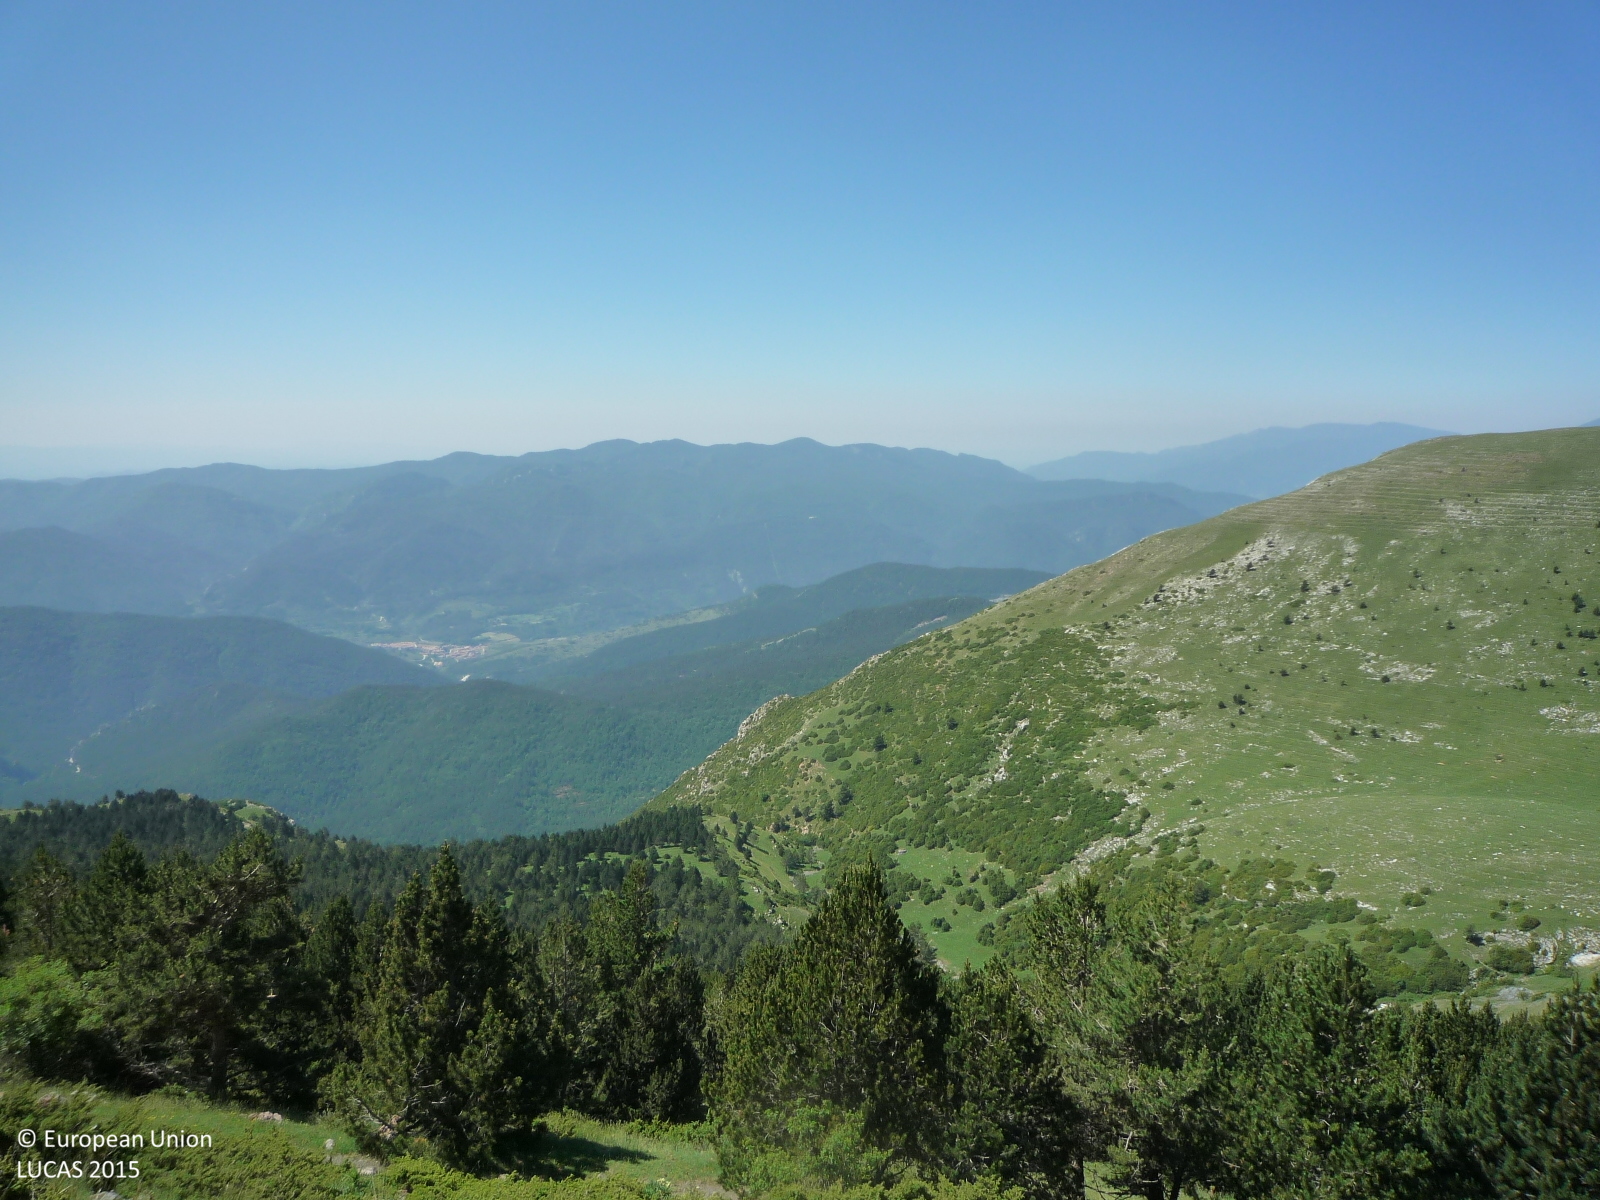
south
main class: Grassland
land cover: Grassland without tree/shrub cover
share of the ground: > 75 %
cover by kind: herbaceous plants 100 %
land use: Semi-natural and natural areas not in use
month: June
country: ES
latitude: 42.2966
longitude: 1.9460
